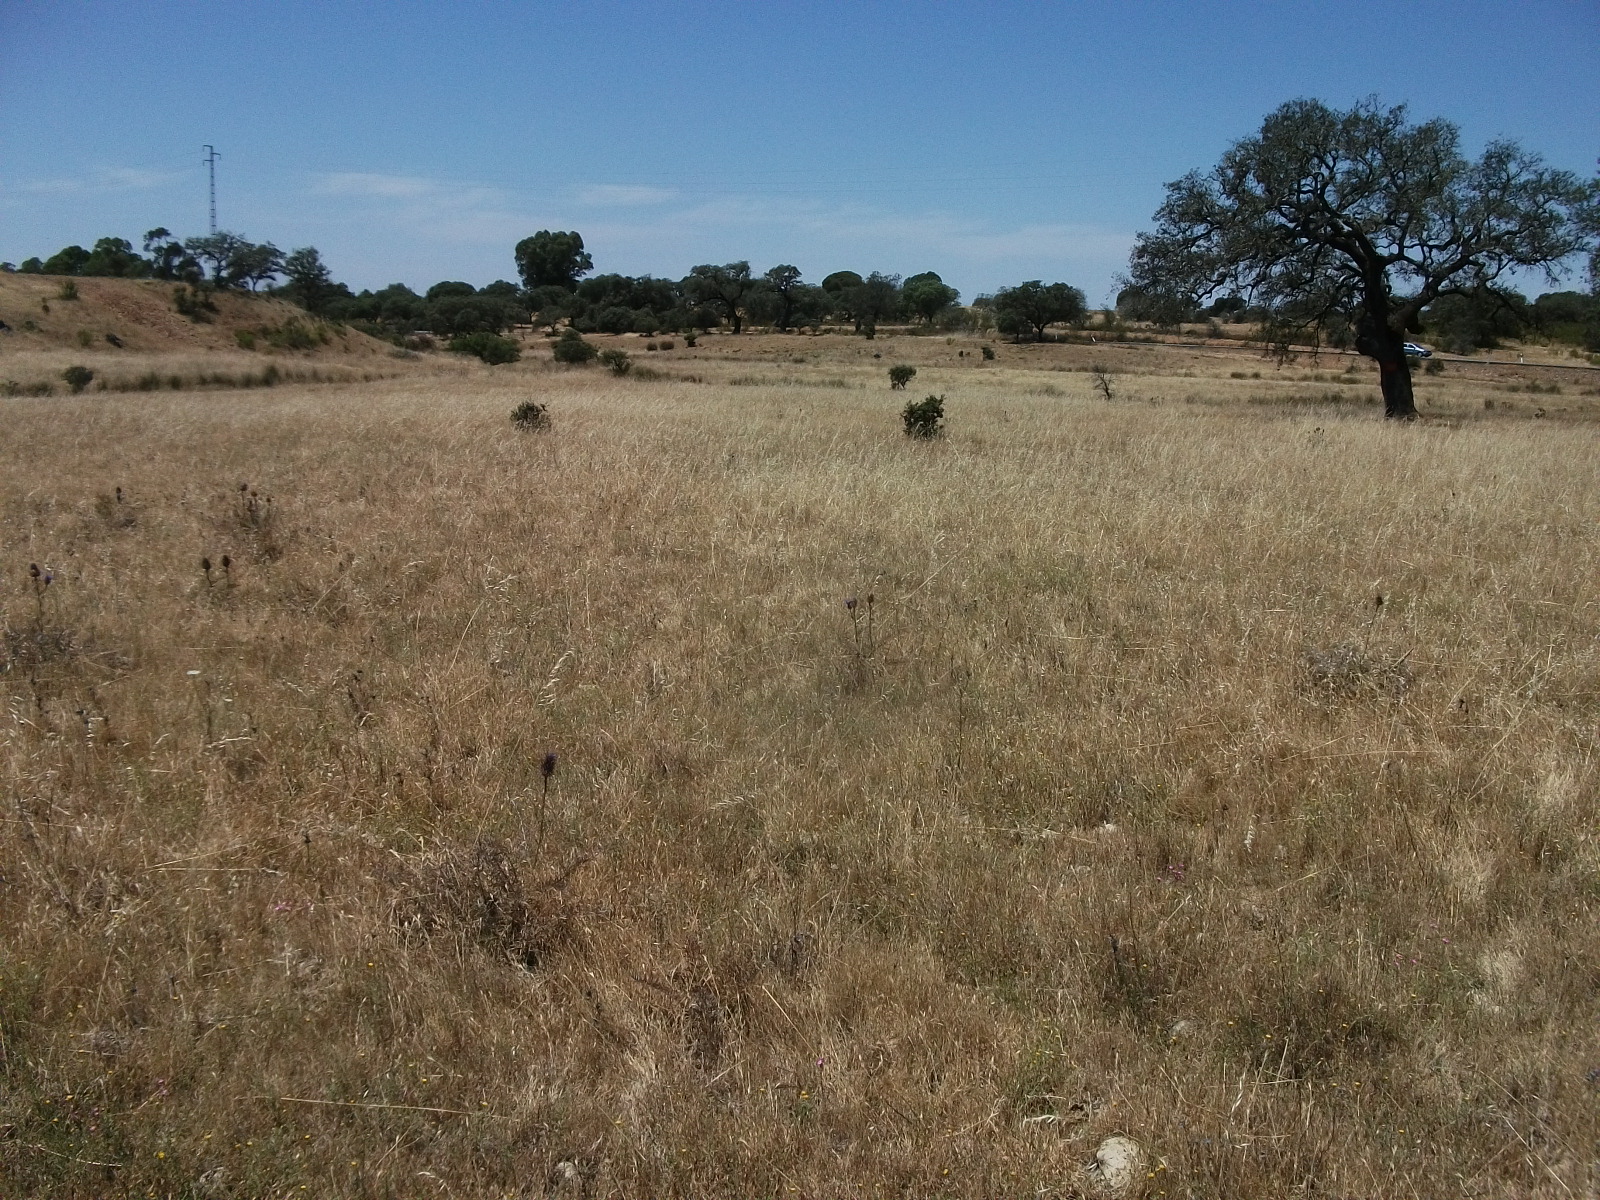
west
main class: Grassland
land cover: Grassland without tree/shrub cover
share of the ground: > 75 %
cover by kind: herbaceous plants 100 %
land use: Agriculture (excluding fallow land and kitchen gardens)
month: June
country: ES
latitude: 37.6625
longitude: -7.1105
